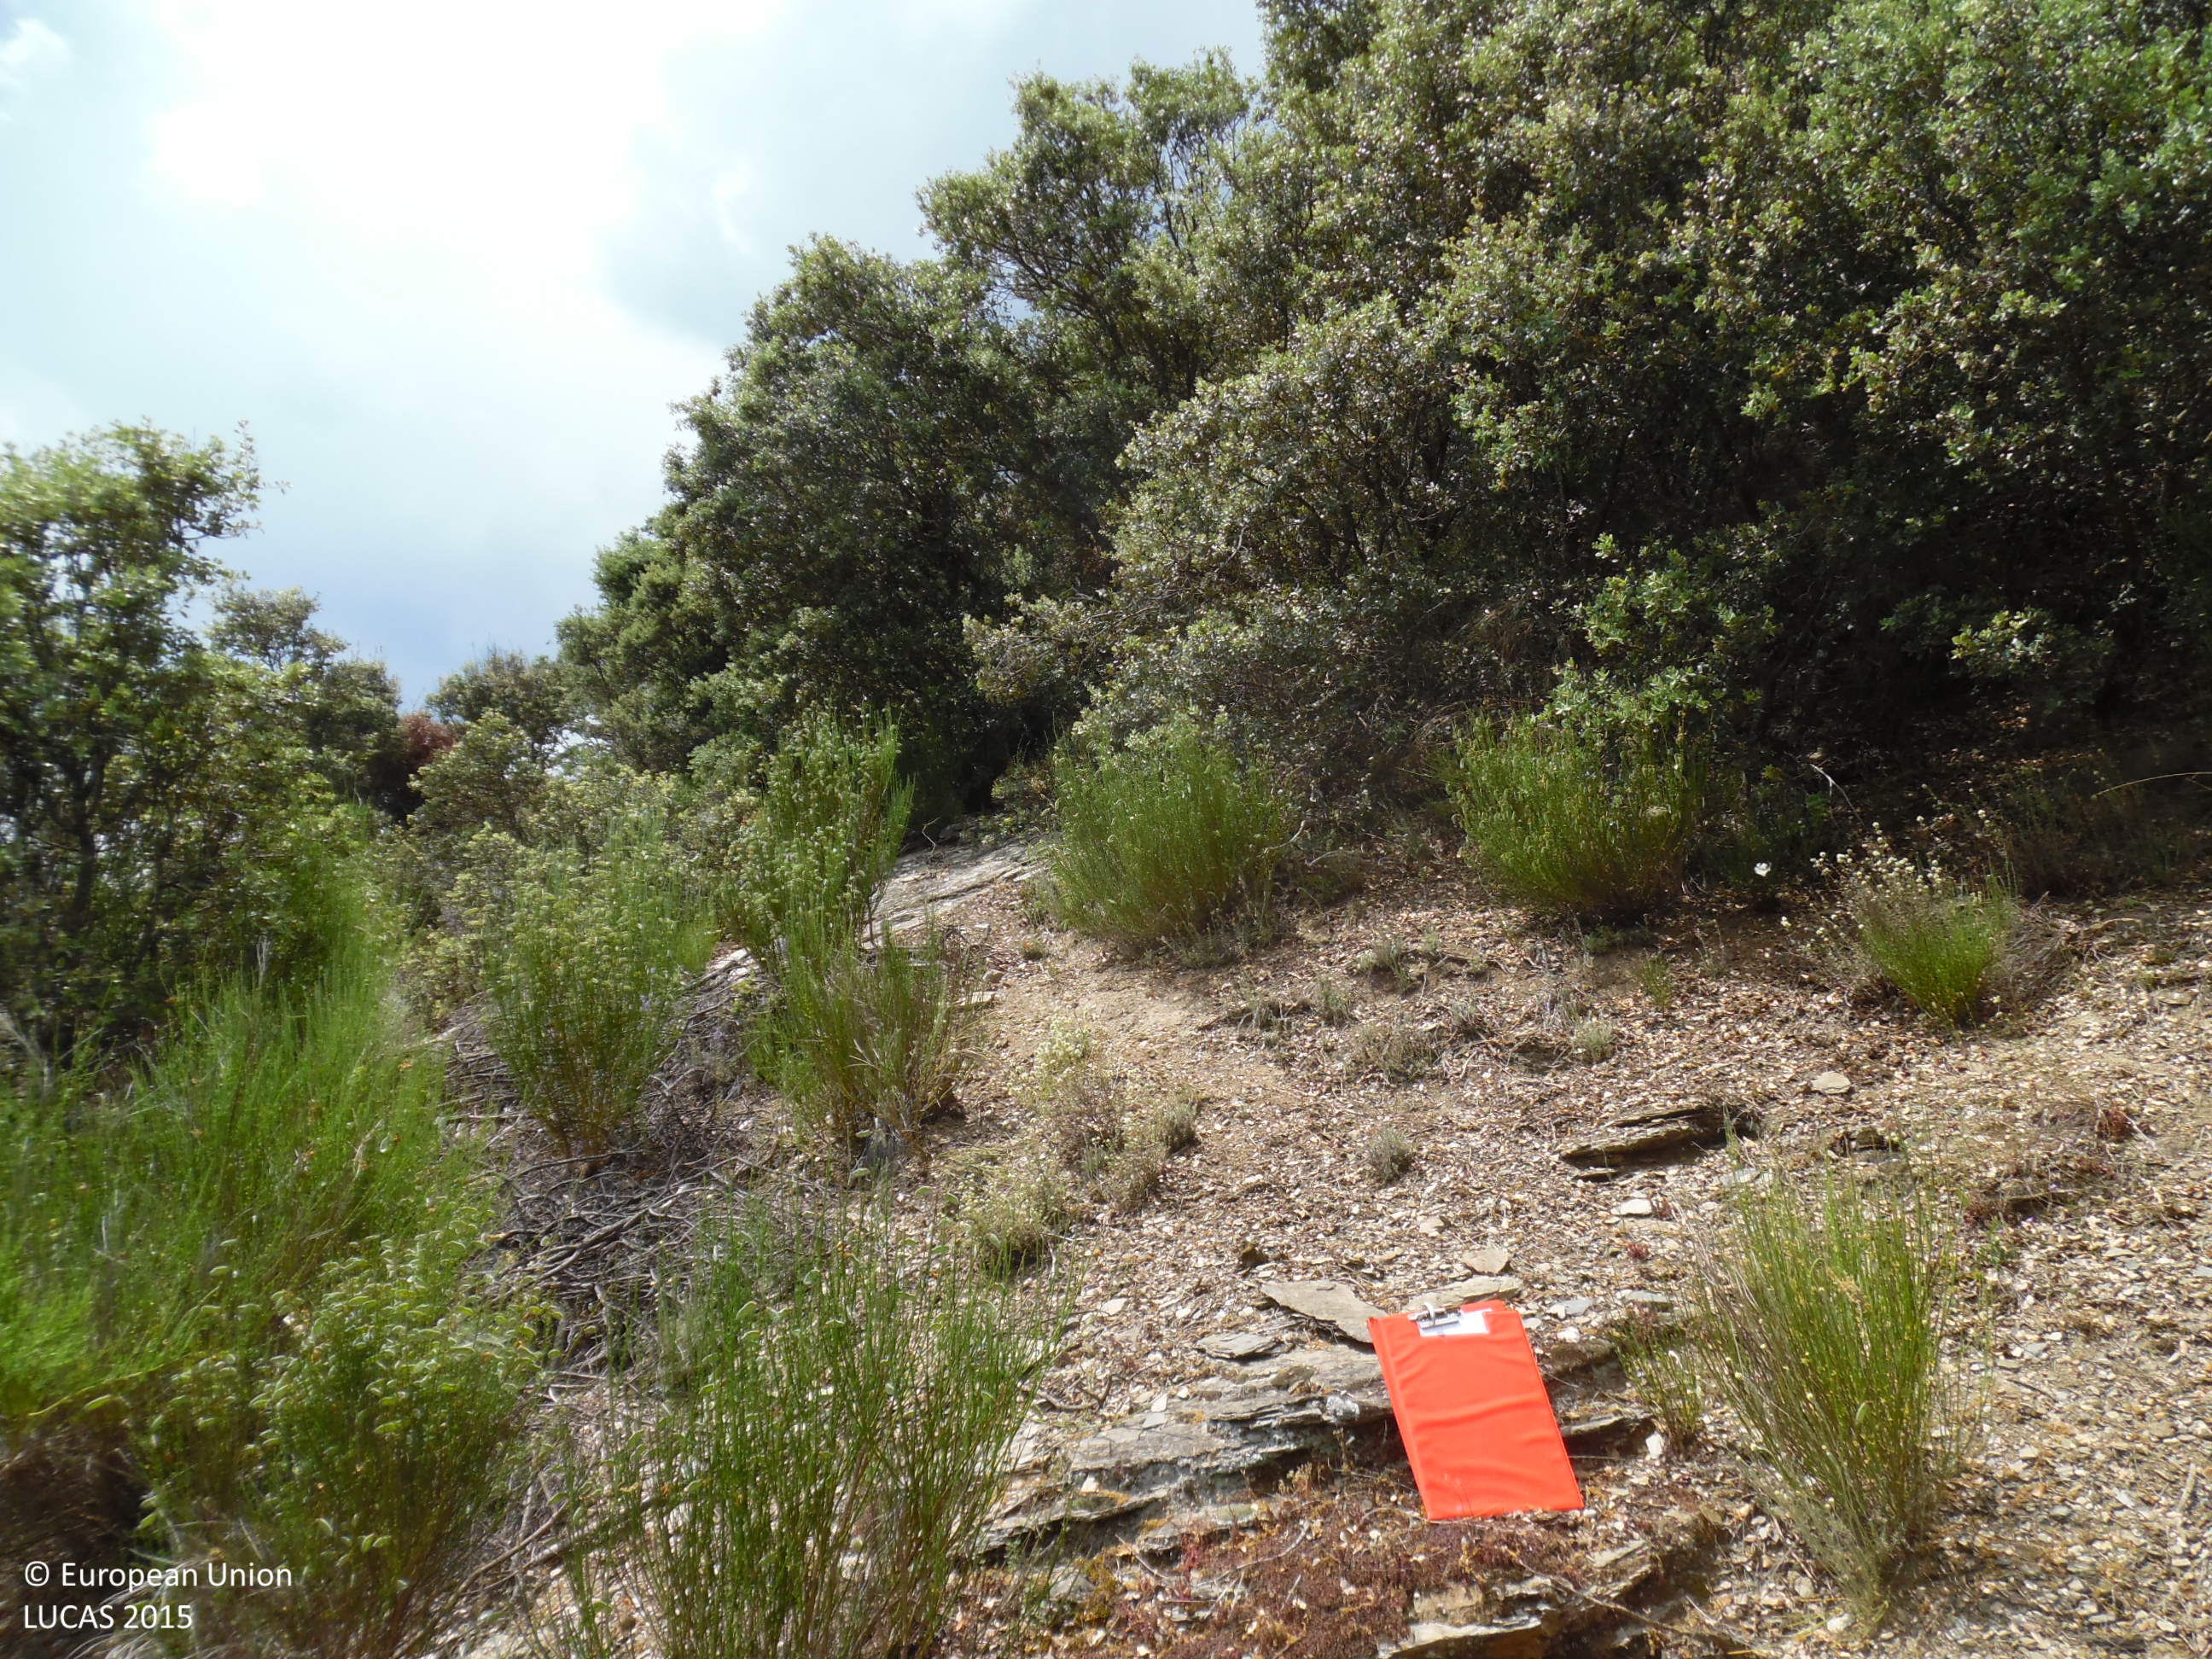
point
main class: Woodland
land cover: Broadleaved woodland
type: broadleaved evergreen forest
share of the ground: > 75 %
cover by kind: broadleaved forest trees 95 %, shrubs 5 %
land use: Forestry
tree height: > 5 m
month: June
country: ES
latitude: 42.2639
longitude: -6.6156
